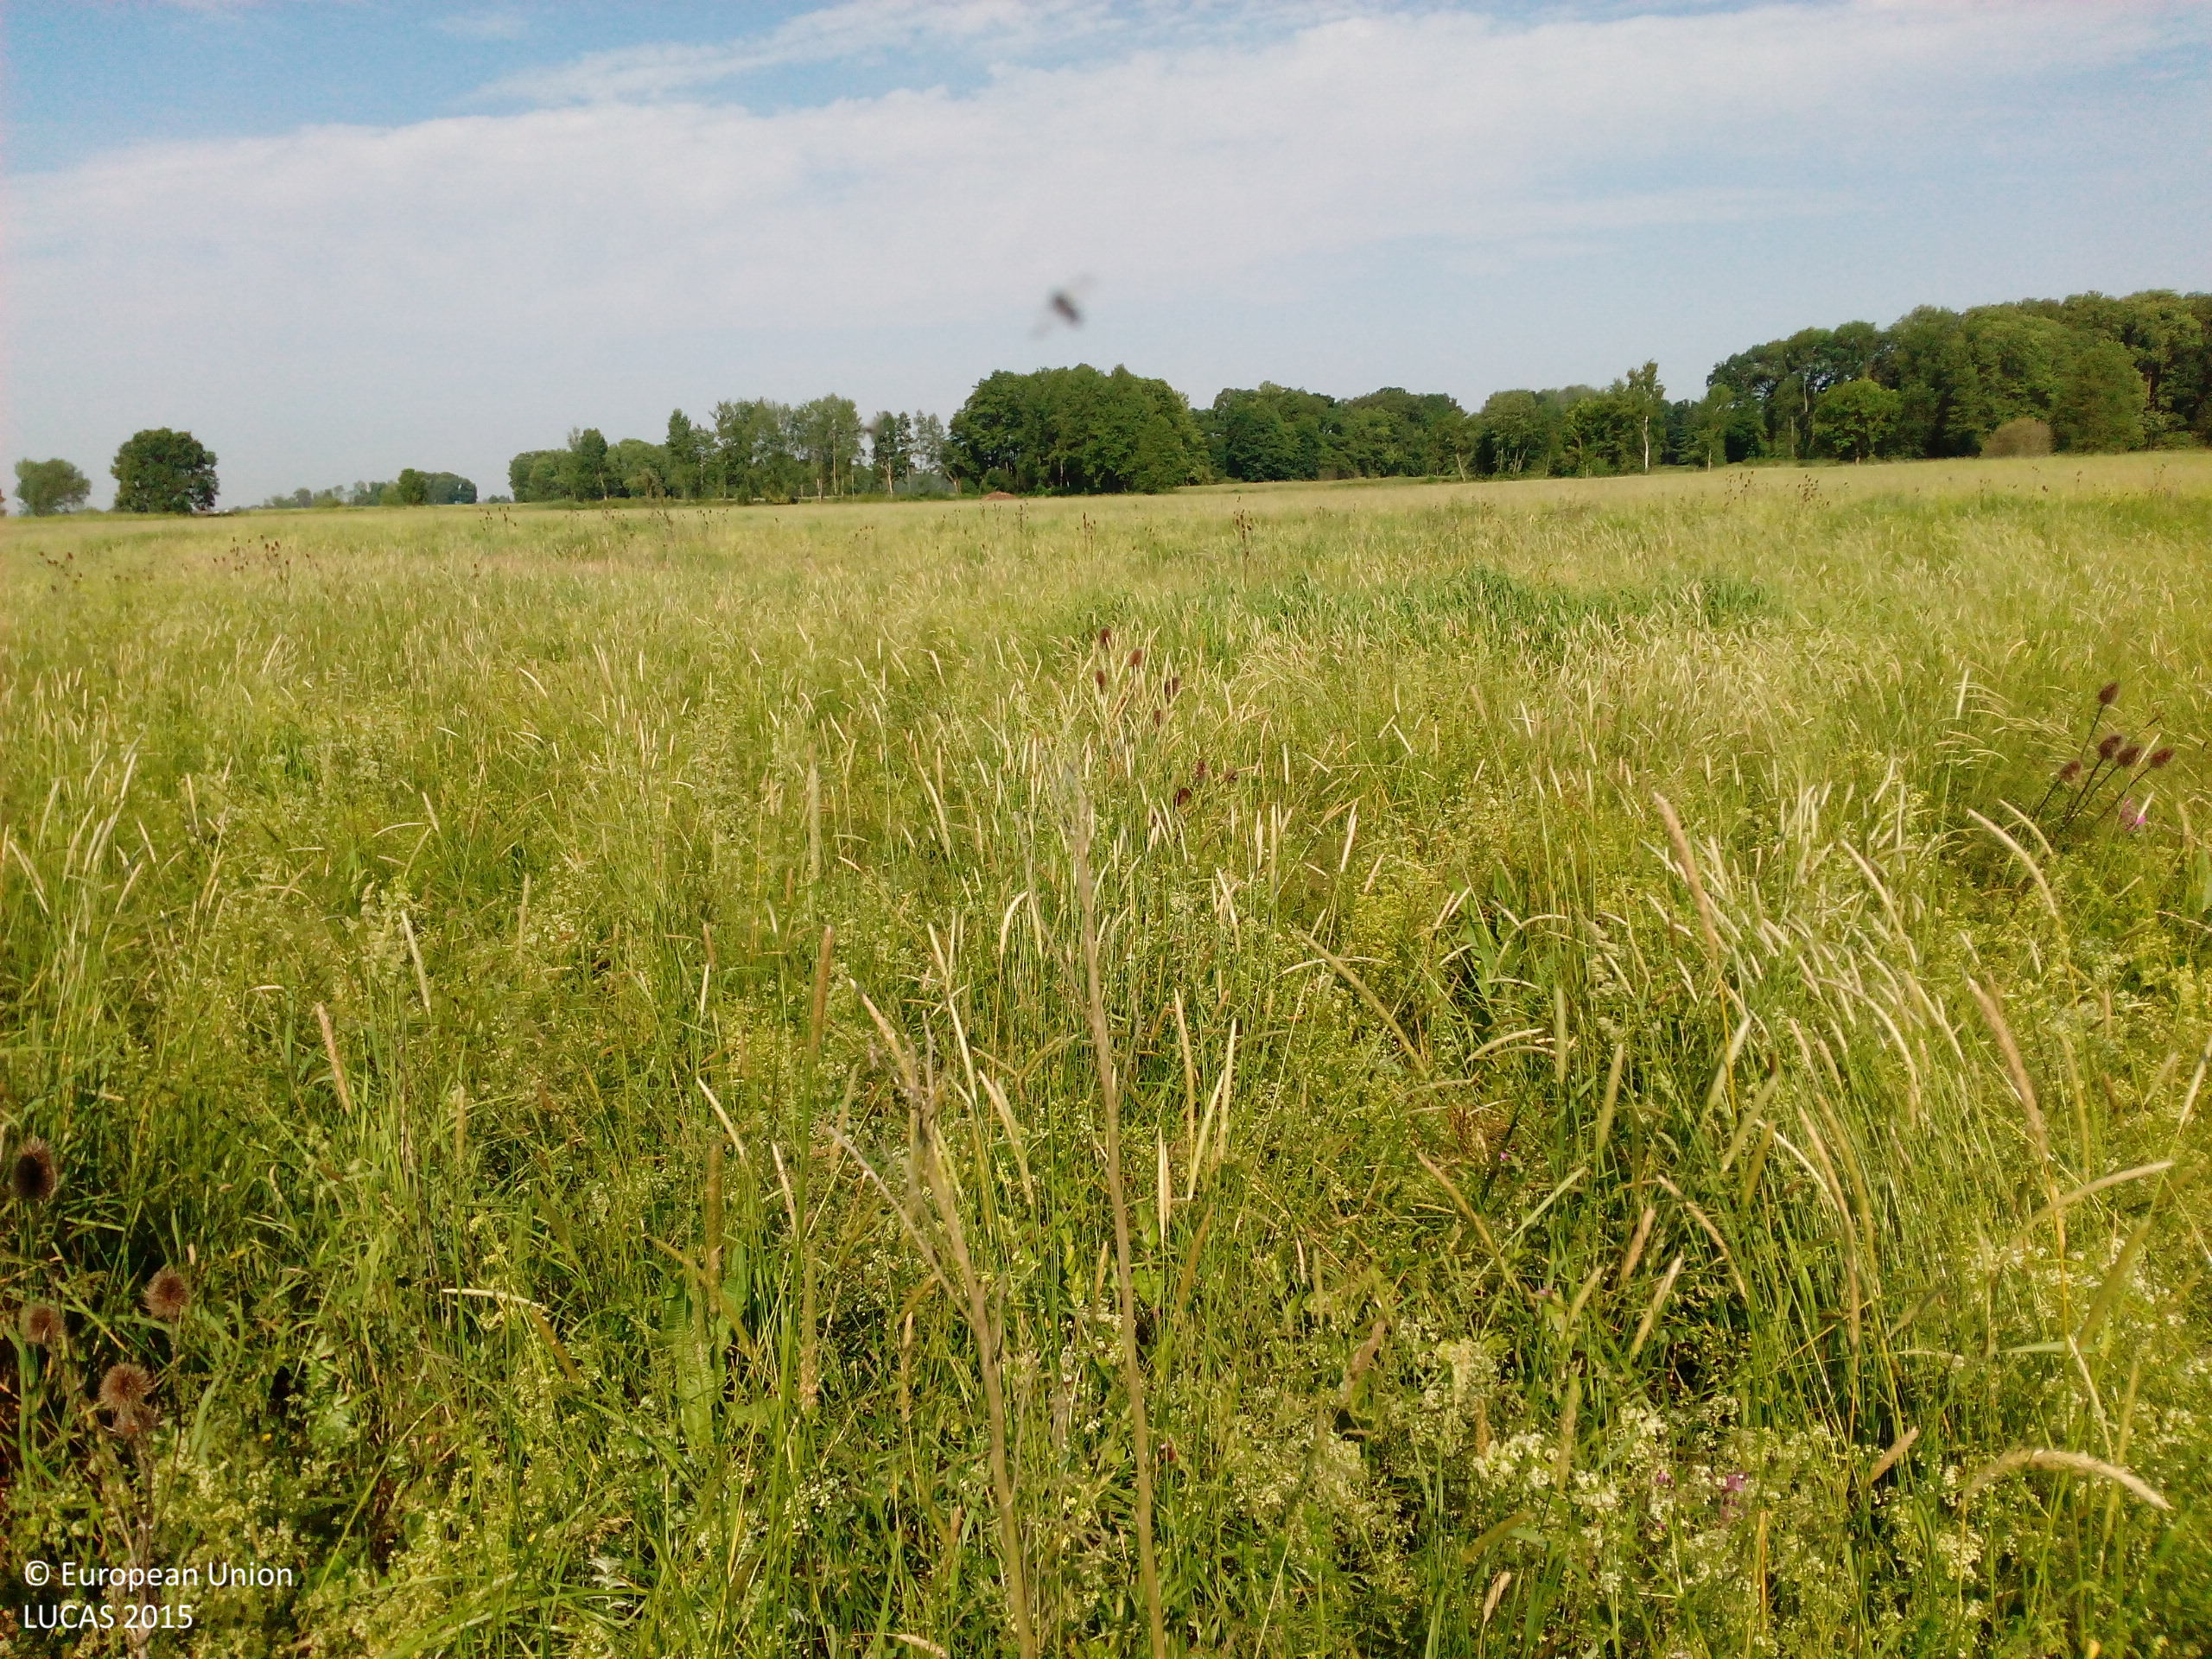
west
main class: Grassland
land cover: Spontaneously vegetated surfaces
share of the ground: > 75 %
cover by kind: herbaceous plants 100 %
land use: Fallow land
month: June
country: DE
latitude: 48.9171
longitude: 12.4147
